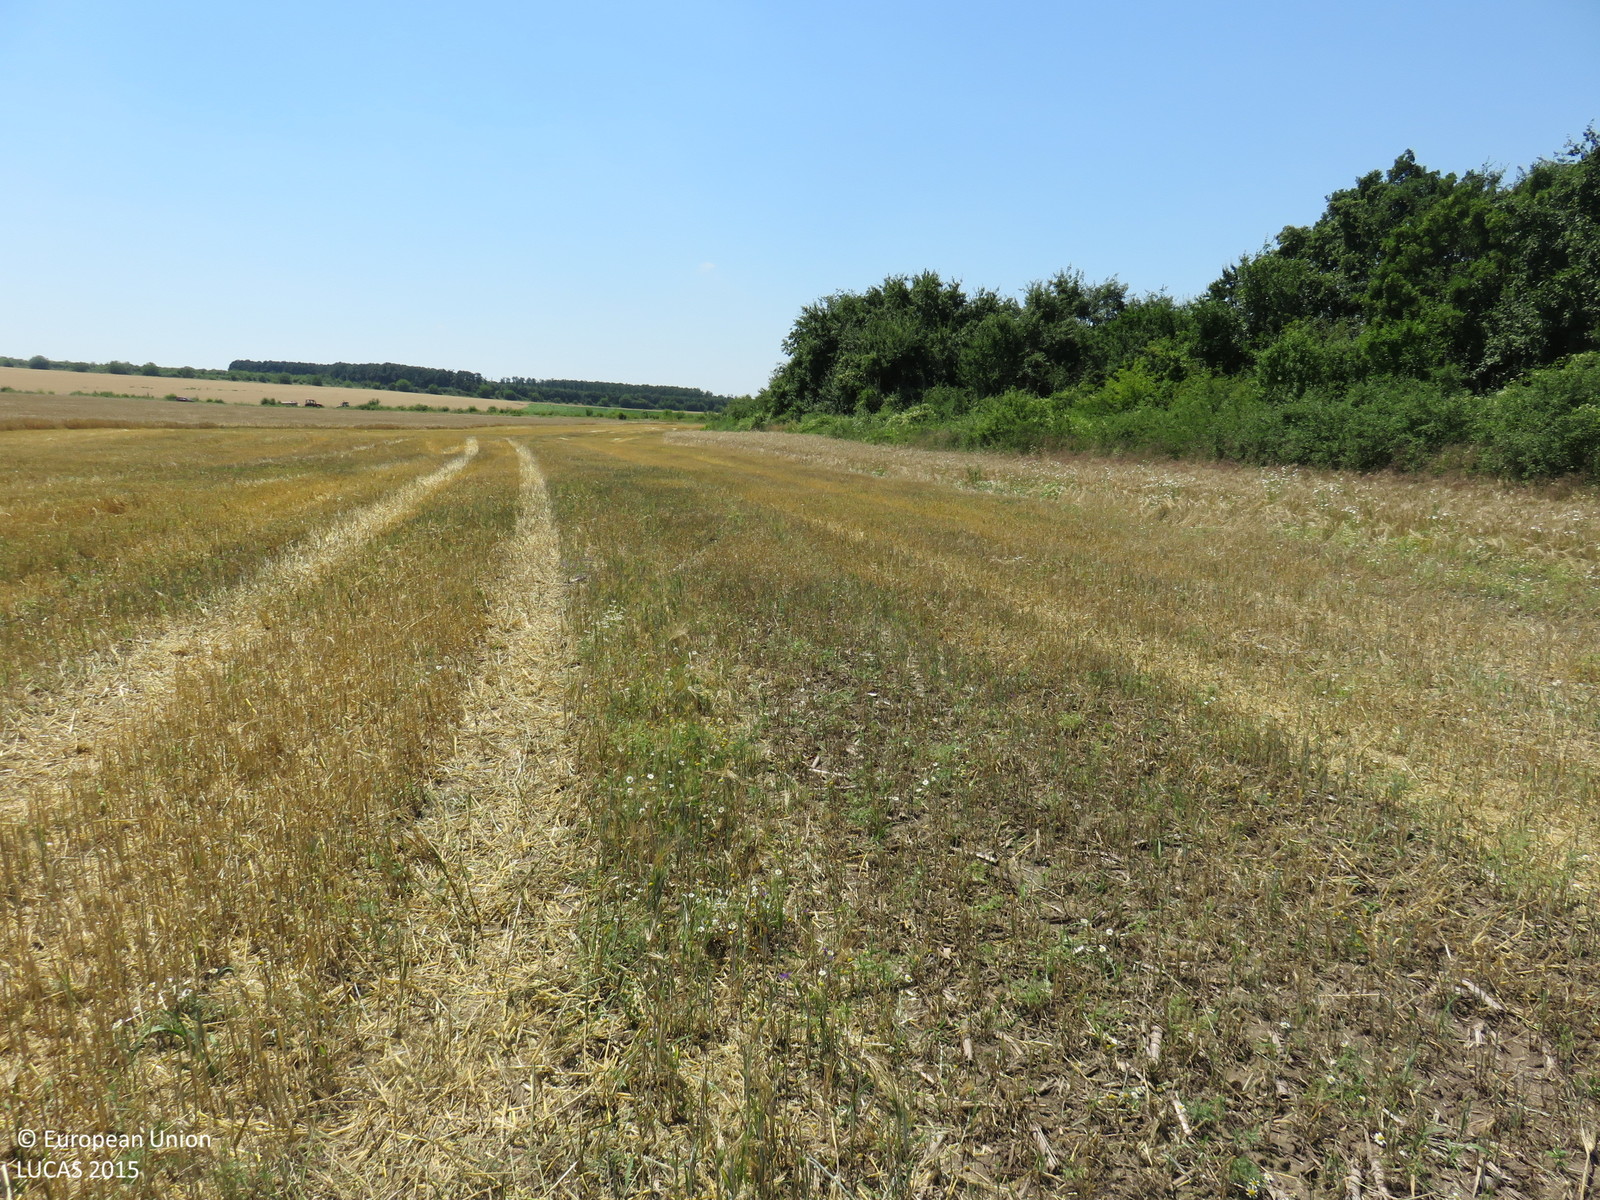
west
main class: Cropland
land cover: Barley
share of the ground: > 75 %
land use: Agriculture (excluding fallow land and kitchen gardens)
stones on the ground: < 10 %
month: June
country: BG
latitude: 43.2588
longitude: 24.8354
